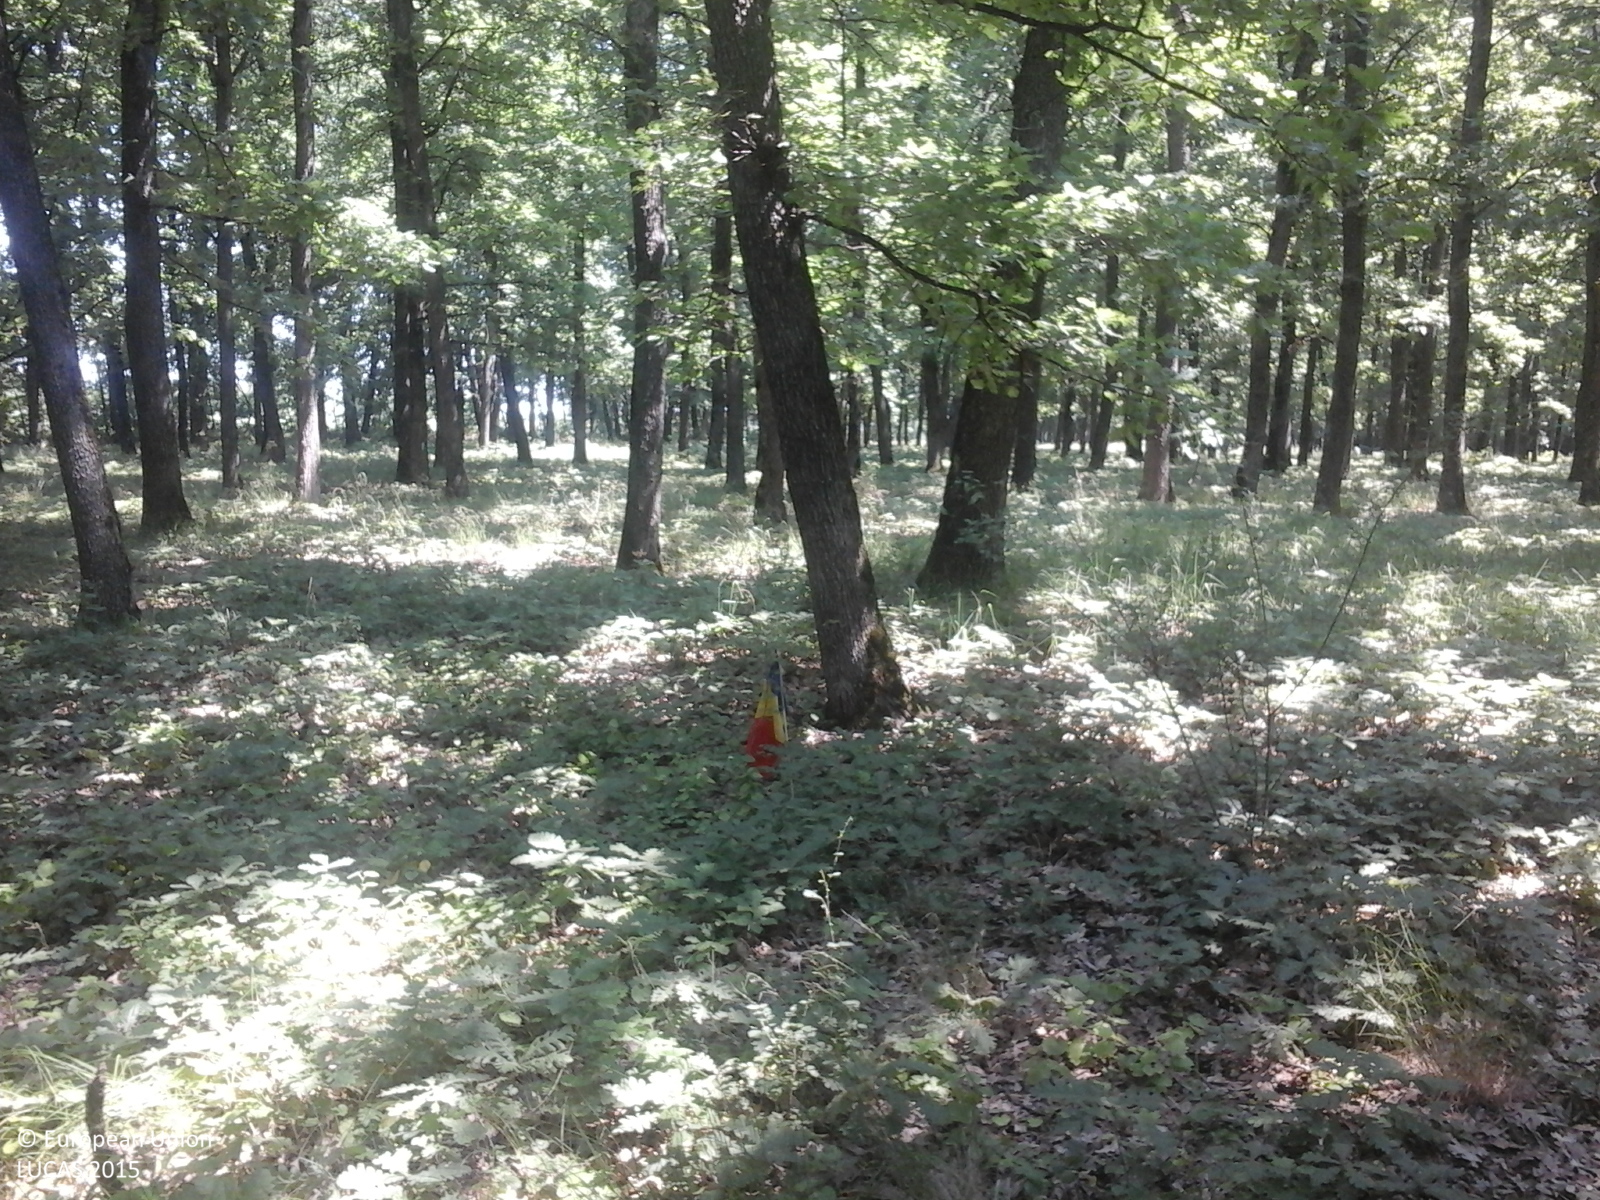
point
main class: Woodland
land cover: Broadleaved woodland
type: acidophilous oak and oak-birch forest
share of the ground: > 75 %
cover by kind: broadleaved forest trees 85 %, herbaceous plants 15 %
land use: Forestry
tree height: > 5 m
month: July
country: RO
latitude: 44.7055
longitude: 24.4476
